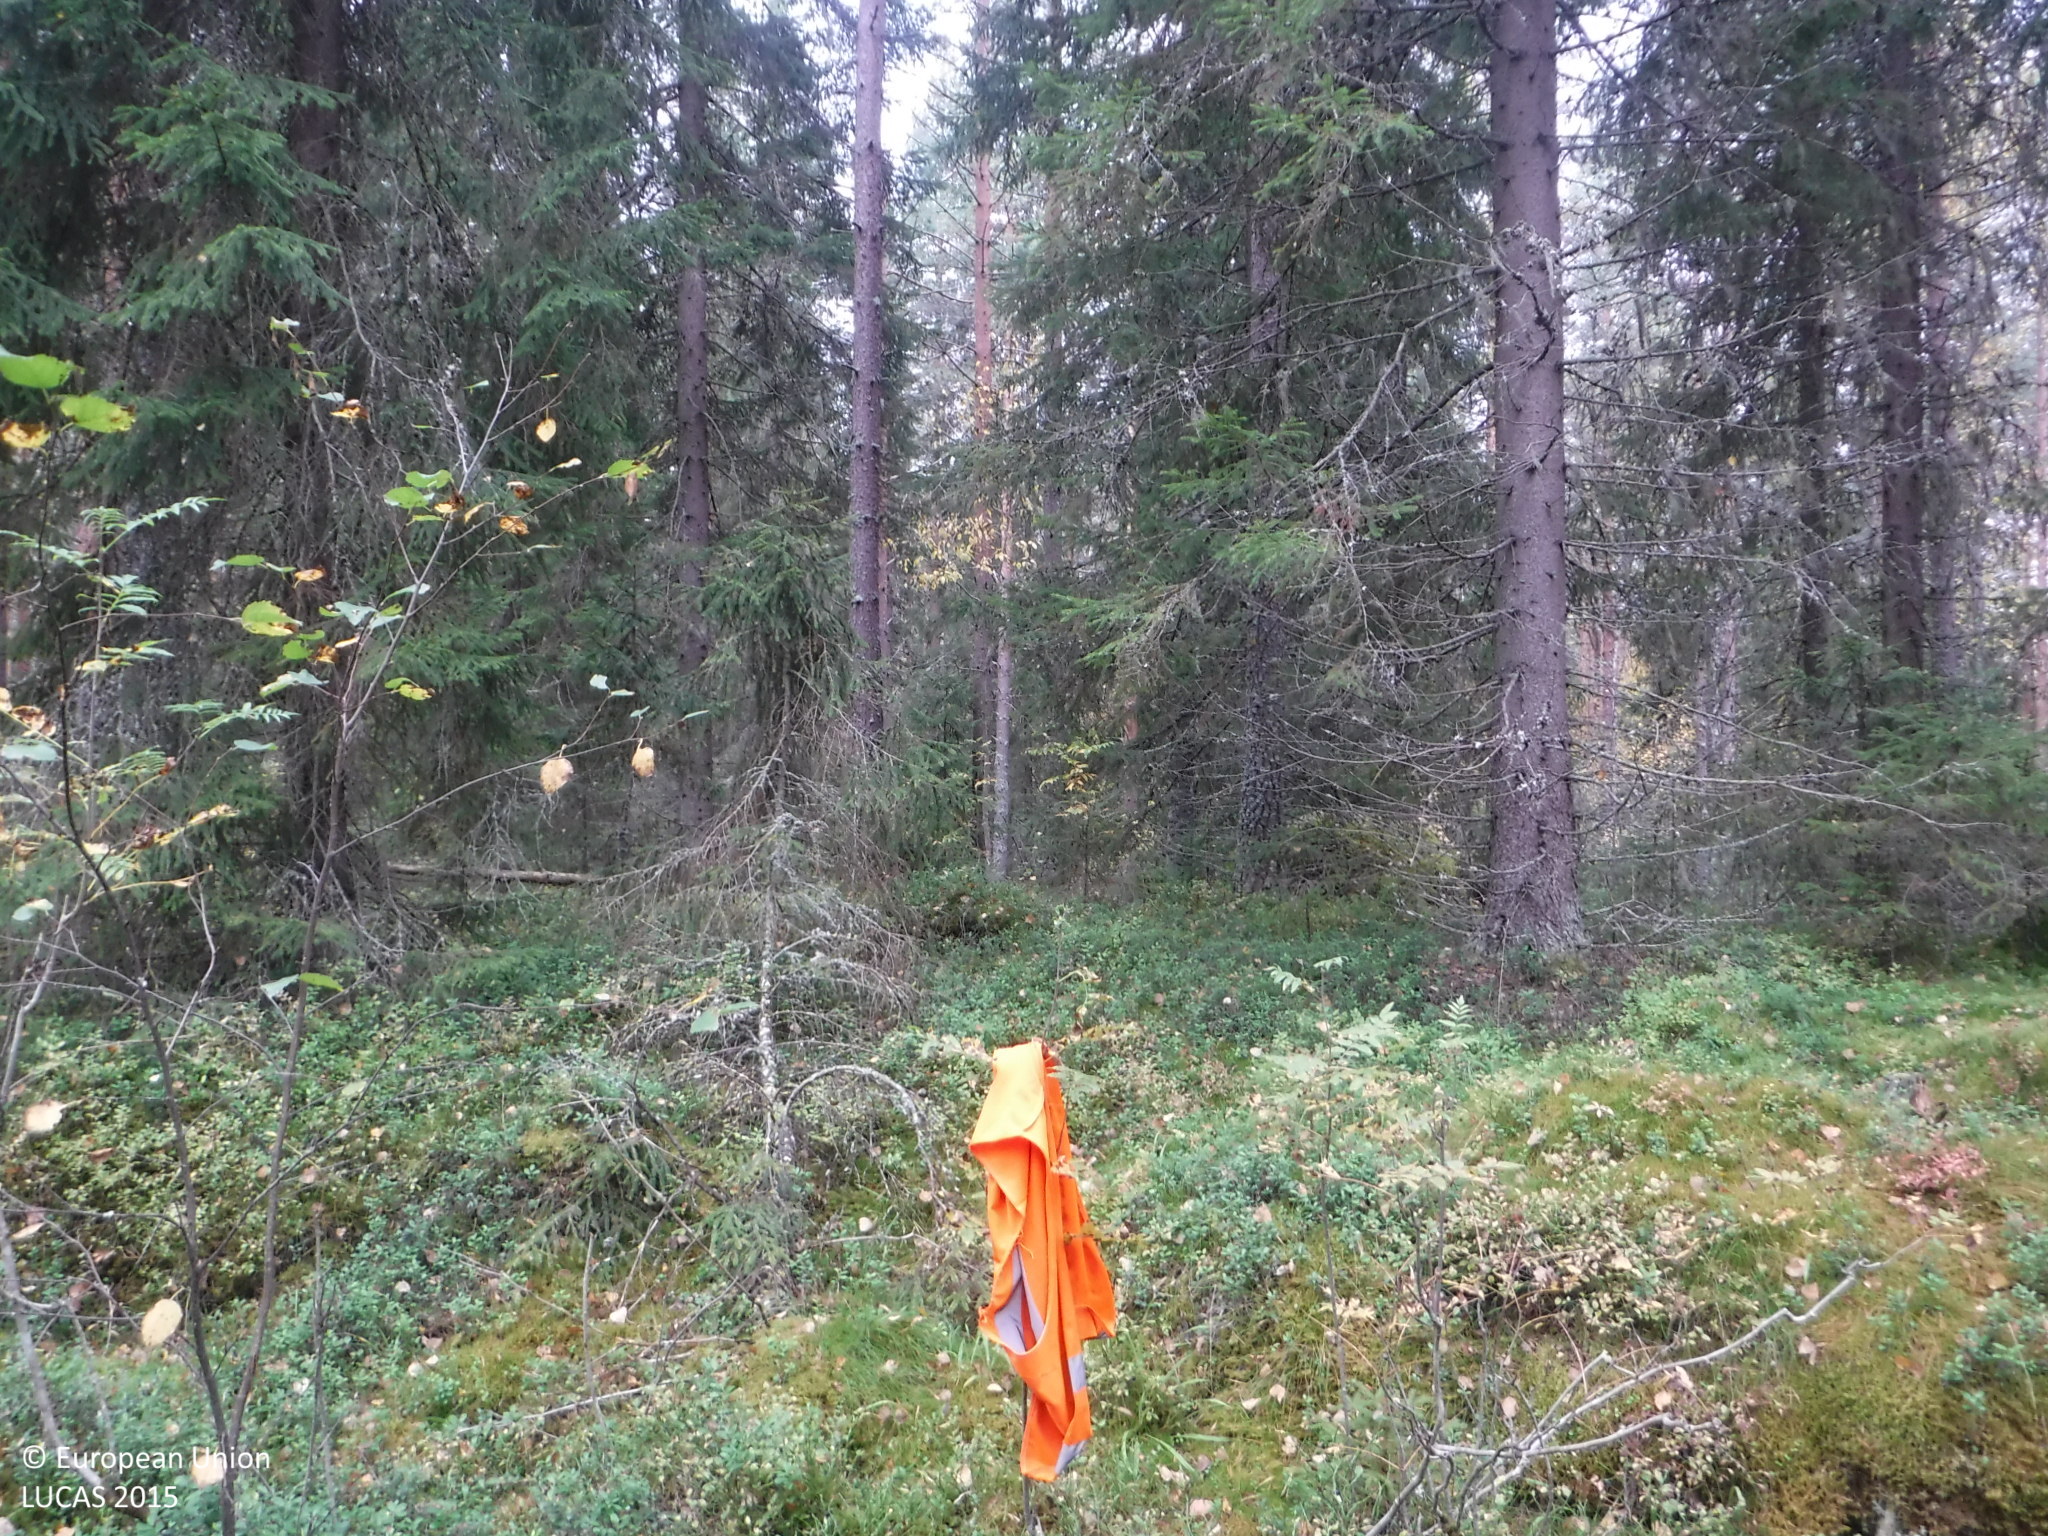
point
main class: Woodland
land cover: Other coniferous woodland
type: boreal forest
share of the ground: 50 - 75 %
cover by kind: coniferous forest trees 55 %, lichens and mosses 20 %, shrubs 15 %, broadleaved forest trees 10 %
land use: Forestry
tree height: > 5 m
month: September
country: FI
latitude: 61.7756
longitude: 24.1342
